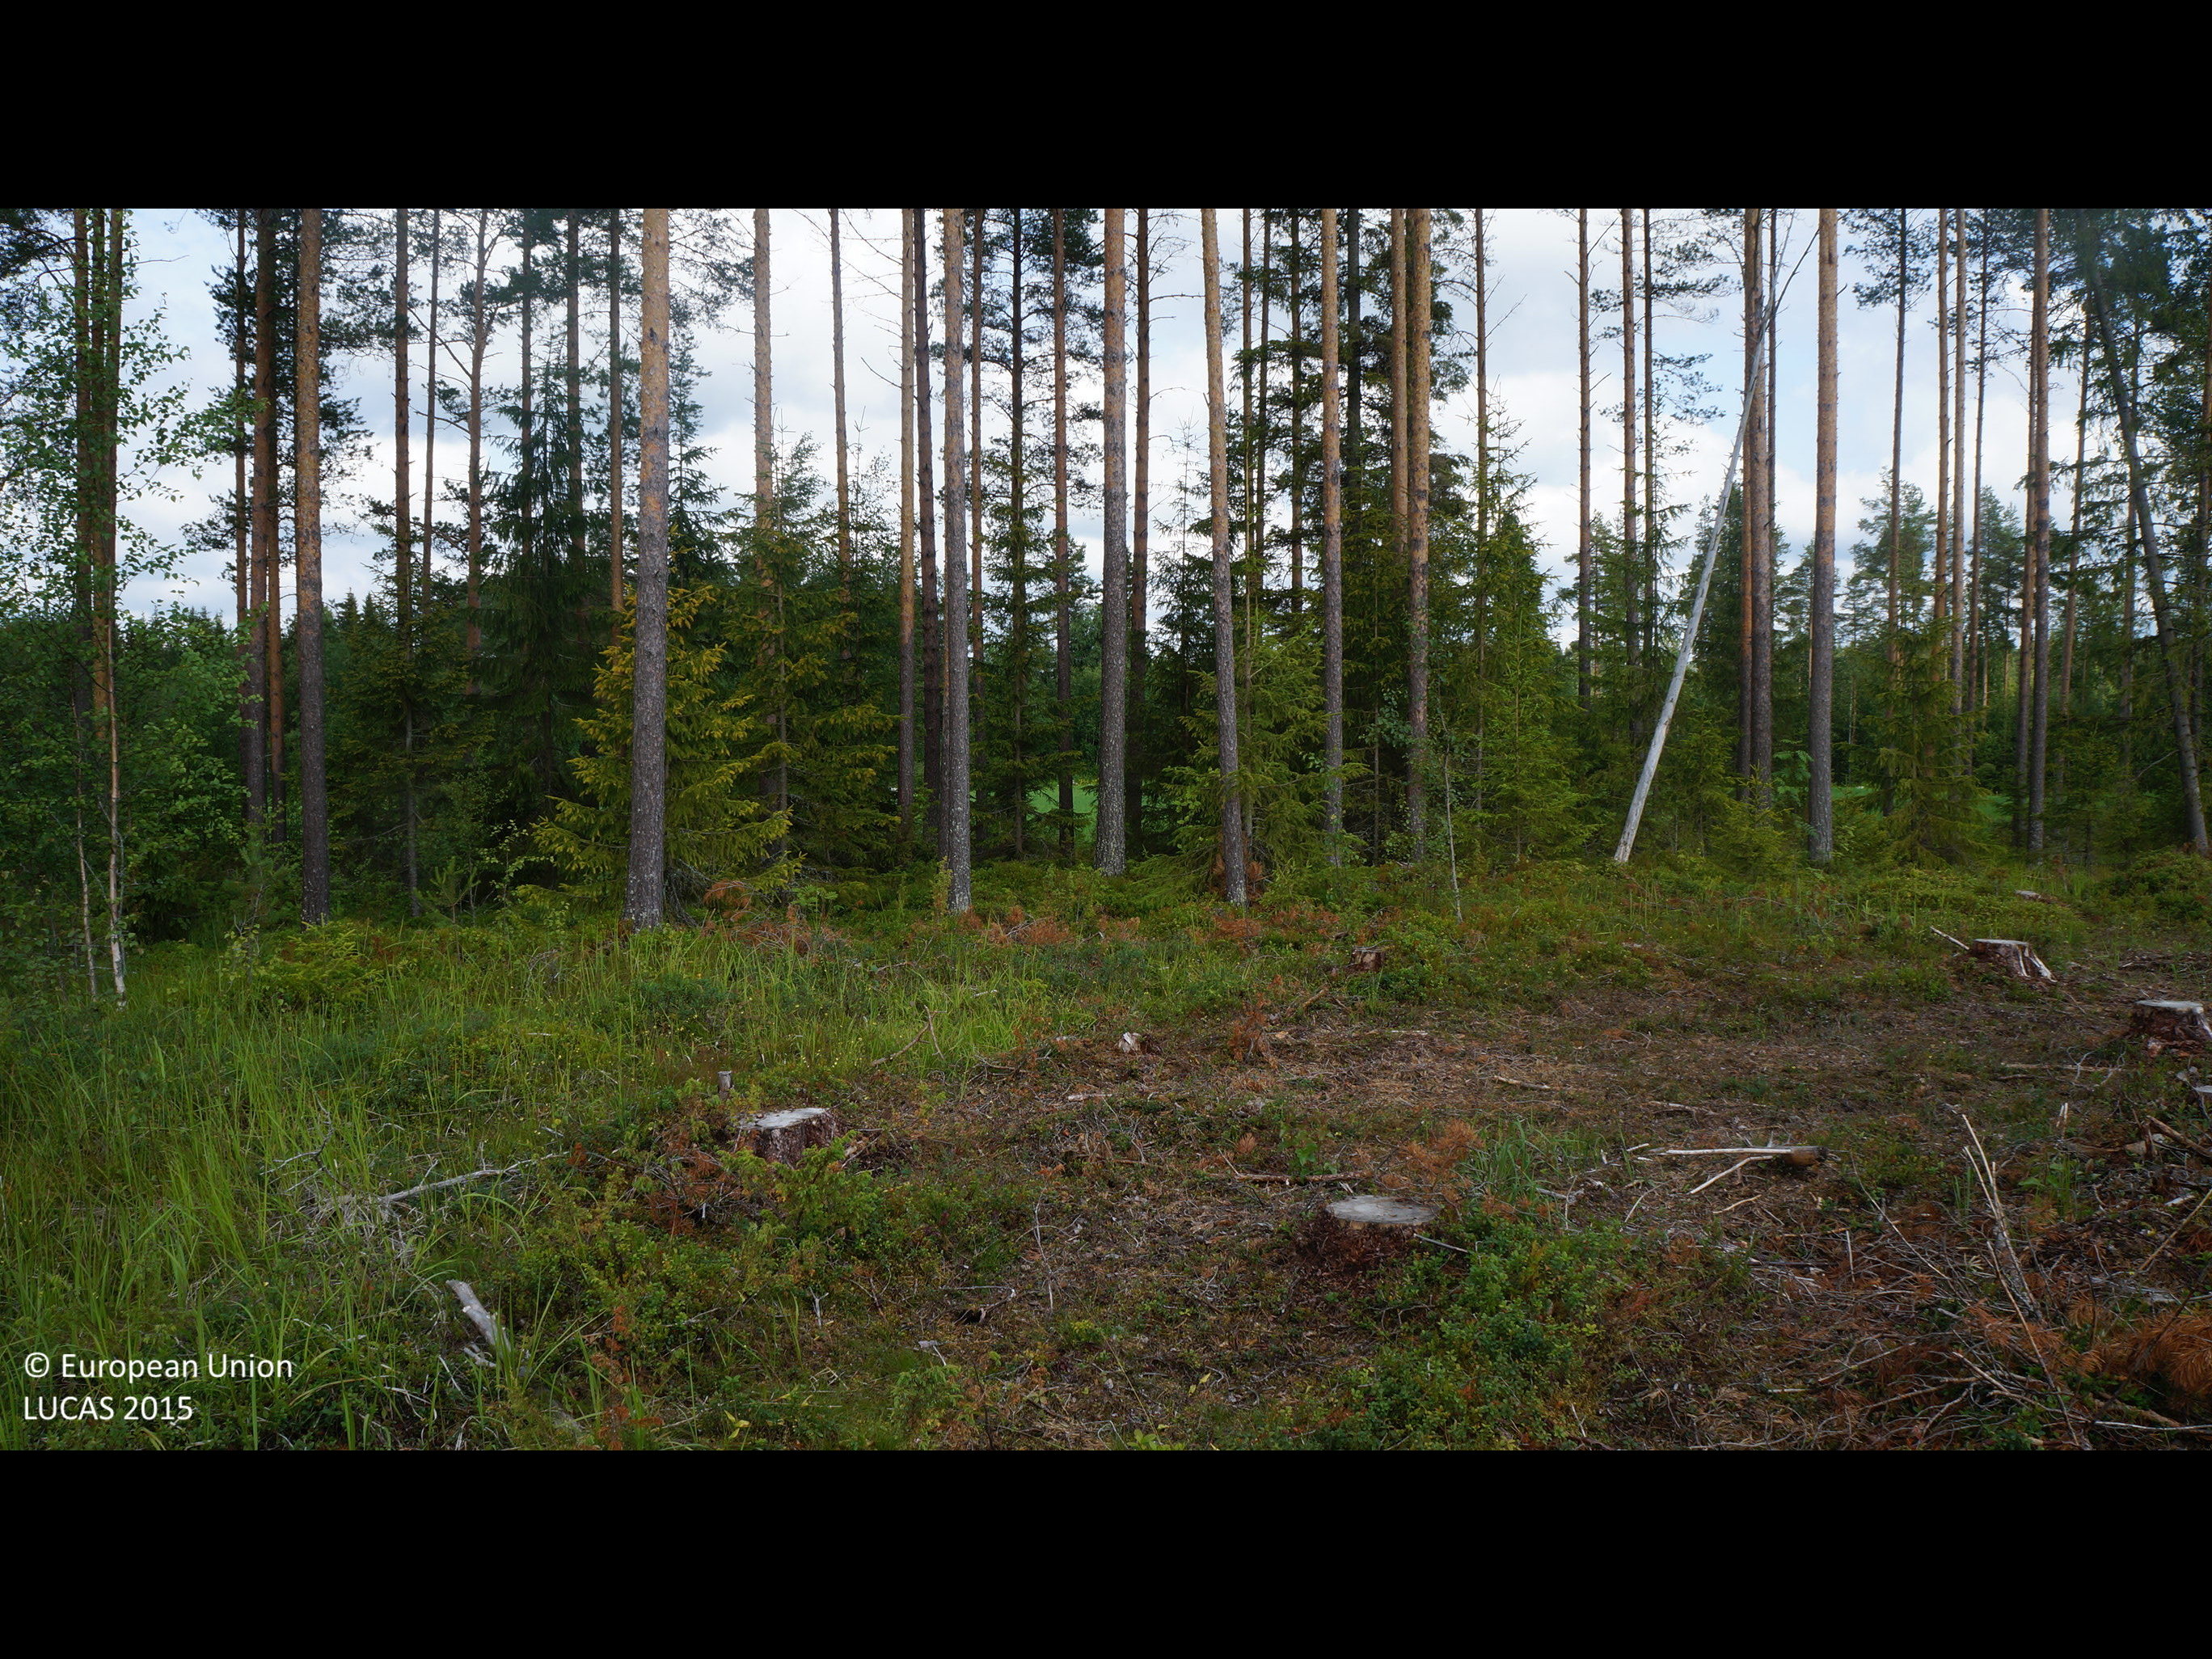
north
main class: Woodland
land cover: Pine dominated coniferous woodland
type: boreal forest
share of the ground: 10 - 25 %
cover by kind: shrubs 80 %, coniferous forest trees 10 %, herbaceous plants 5 %, lichens and mosses 5 %
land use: Forestry
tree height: > 5 m
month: July
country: FI
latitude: 64.1110
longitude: 24.3368
